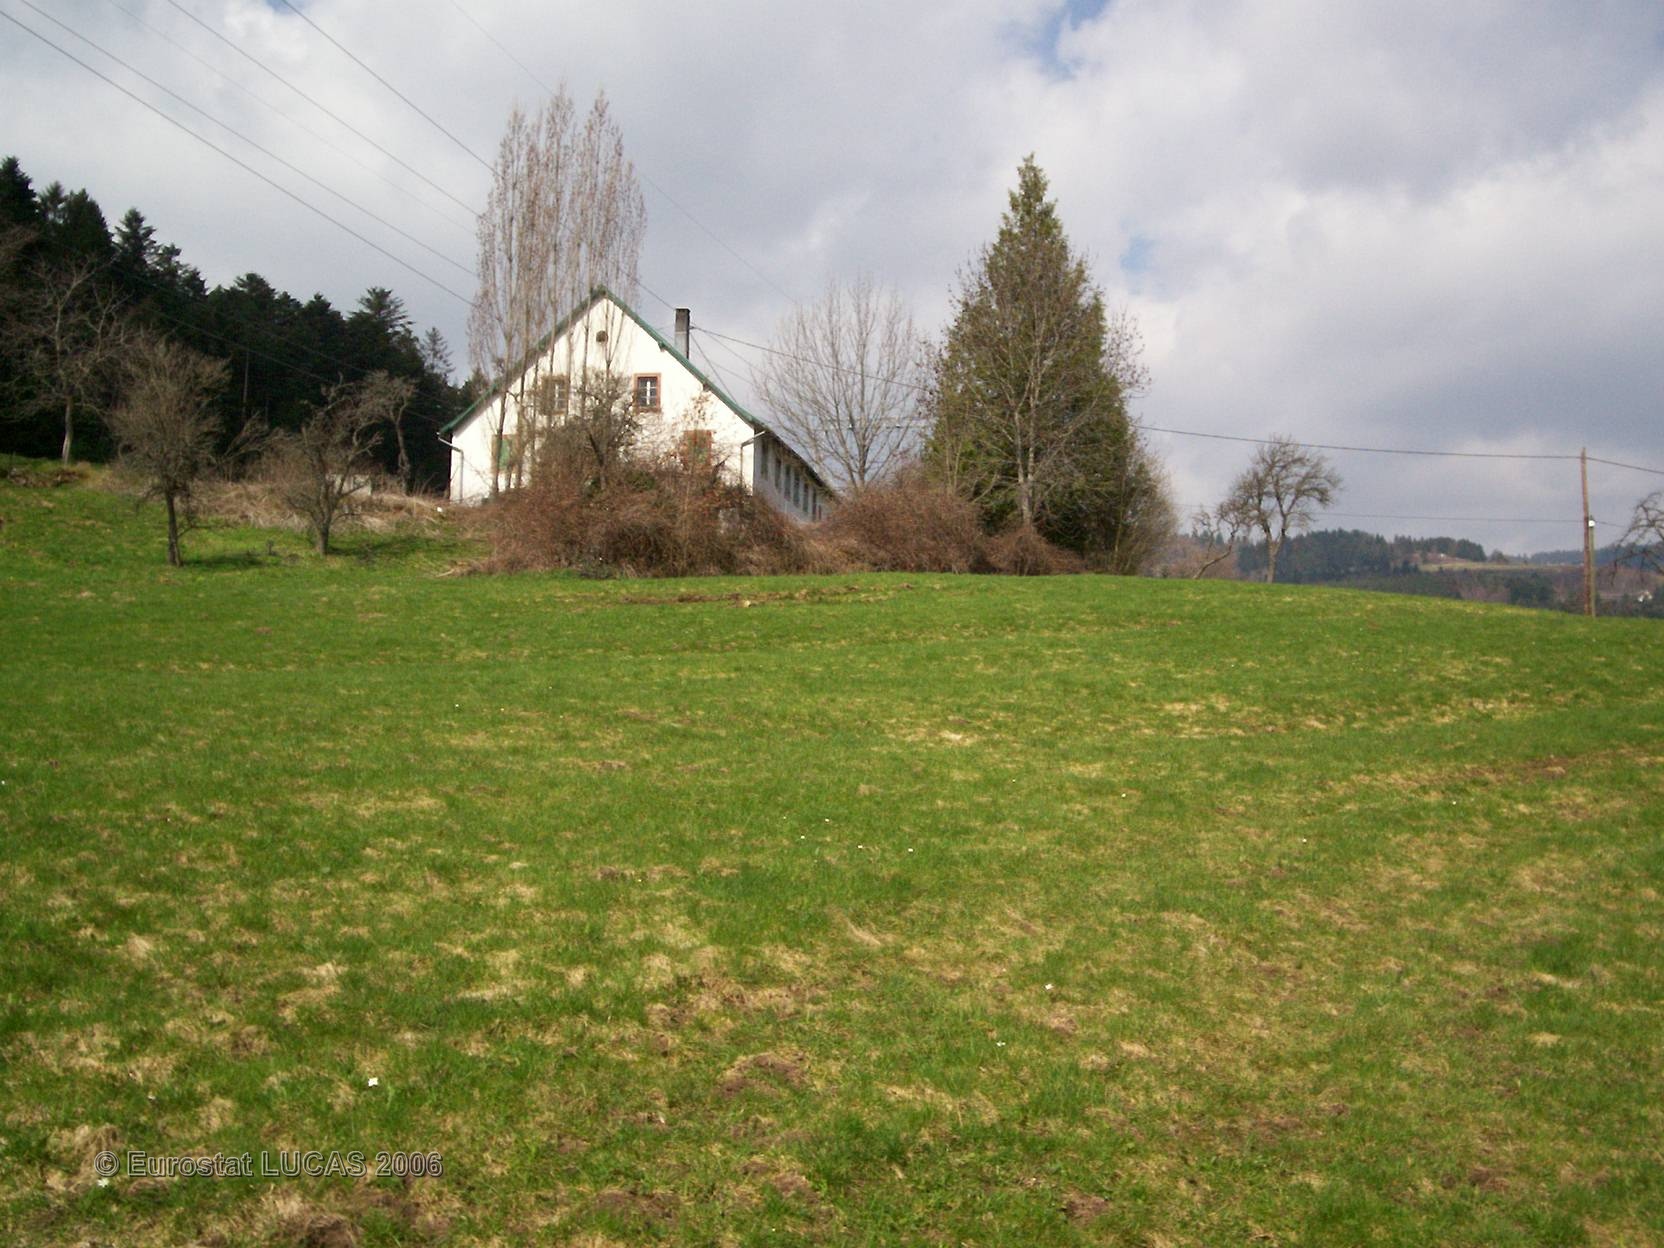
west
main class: Grassland
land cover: Grassland without tree/shrub cover
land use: Agriculture (excluding fallow land and kitchen gardens)
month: April
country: FR
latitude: 48.1144
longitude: 7.1400
